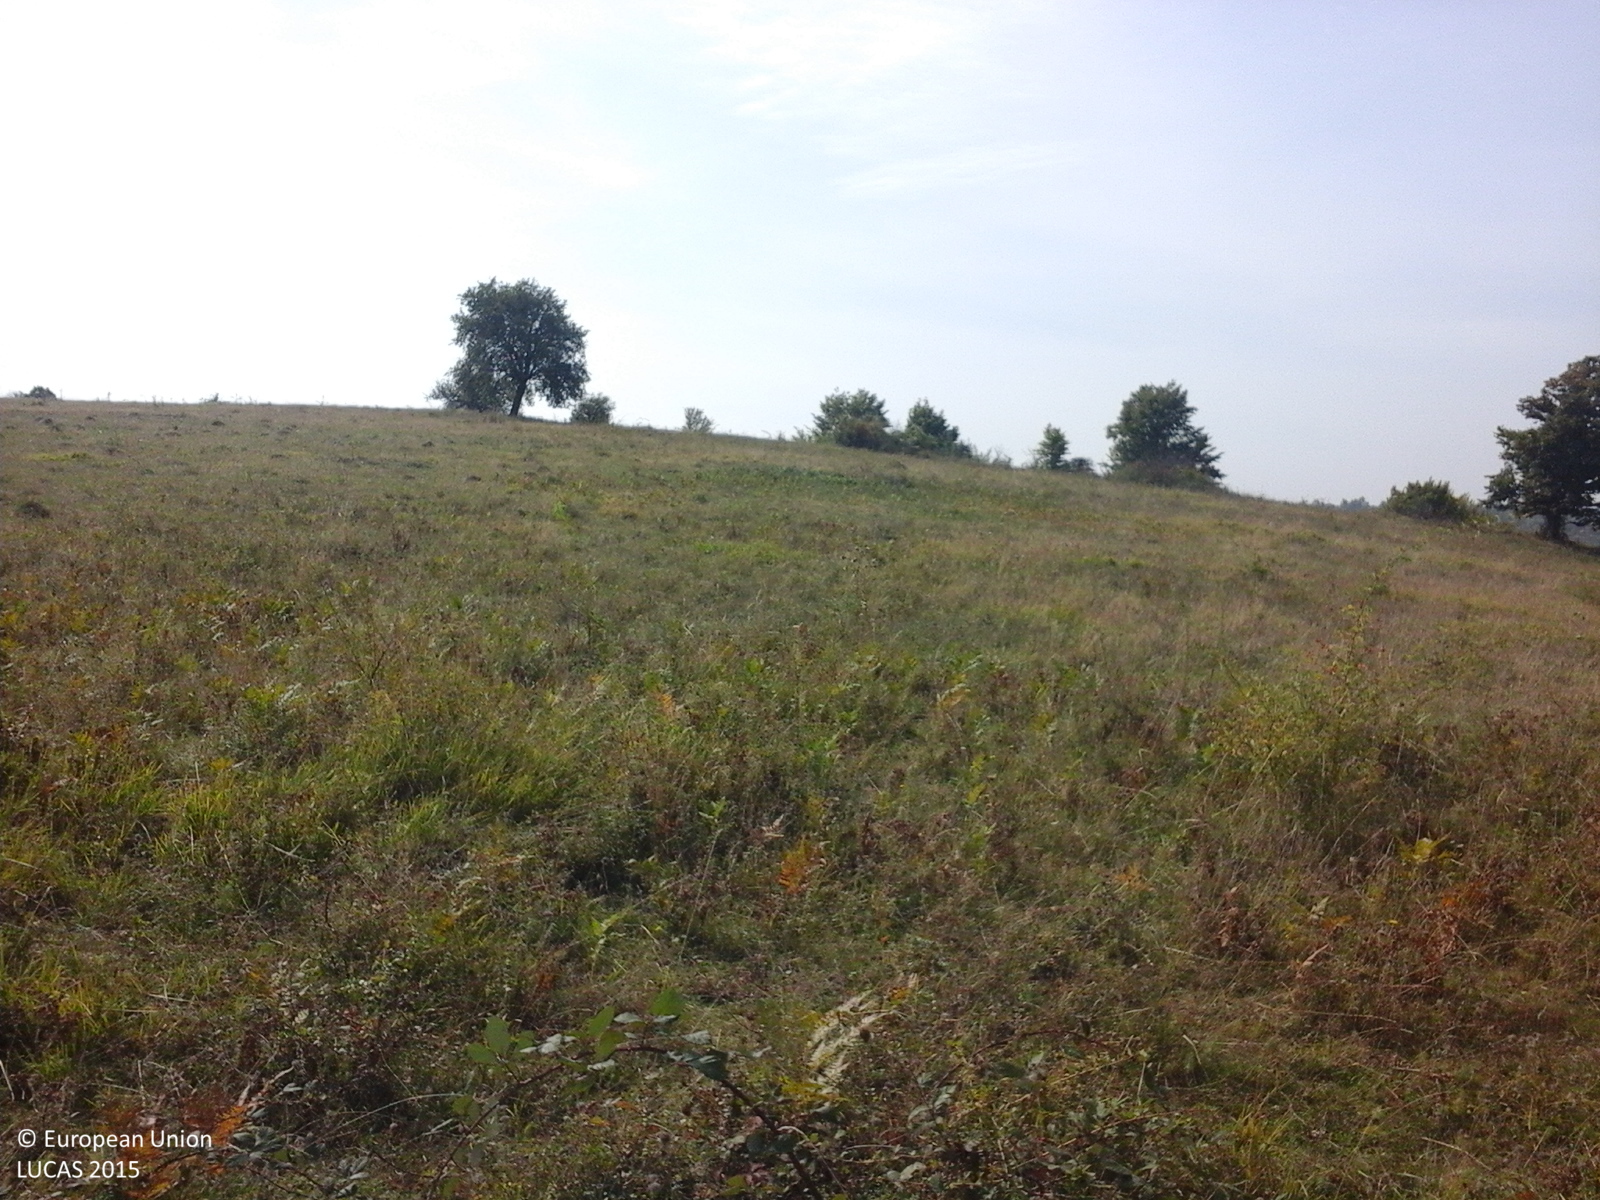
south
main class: Grassland
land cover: Grassland with sparse tree/shrub cover
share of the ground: > 75 %
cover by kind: herbaceous plants 85 %, shrubs 10 %, broadleaved forest trees 5 %
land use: Fallow land
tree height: < 5 m
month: September
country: RO
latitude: 46.8736
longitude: 23.0914
